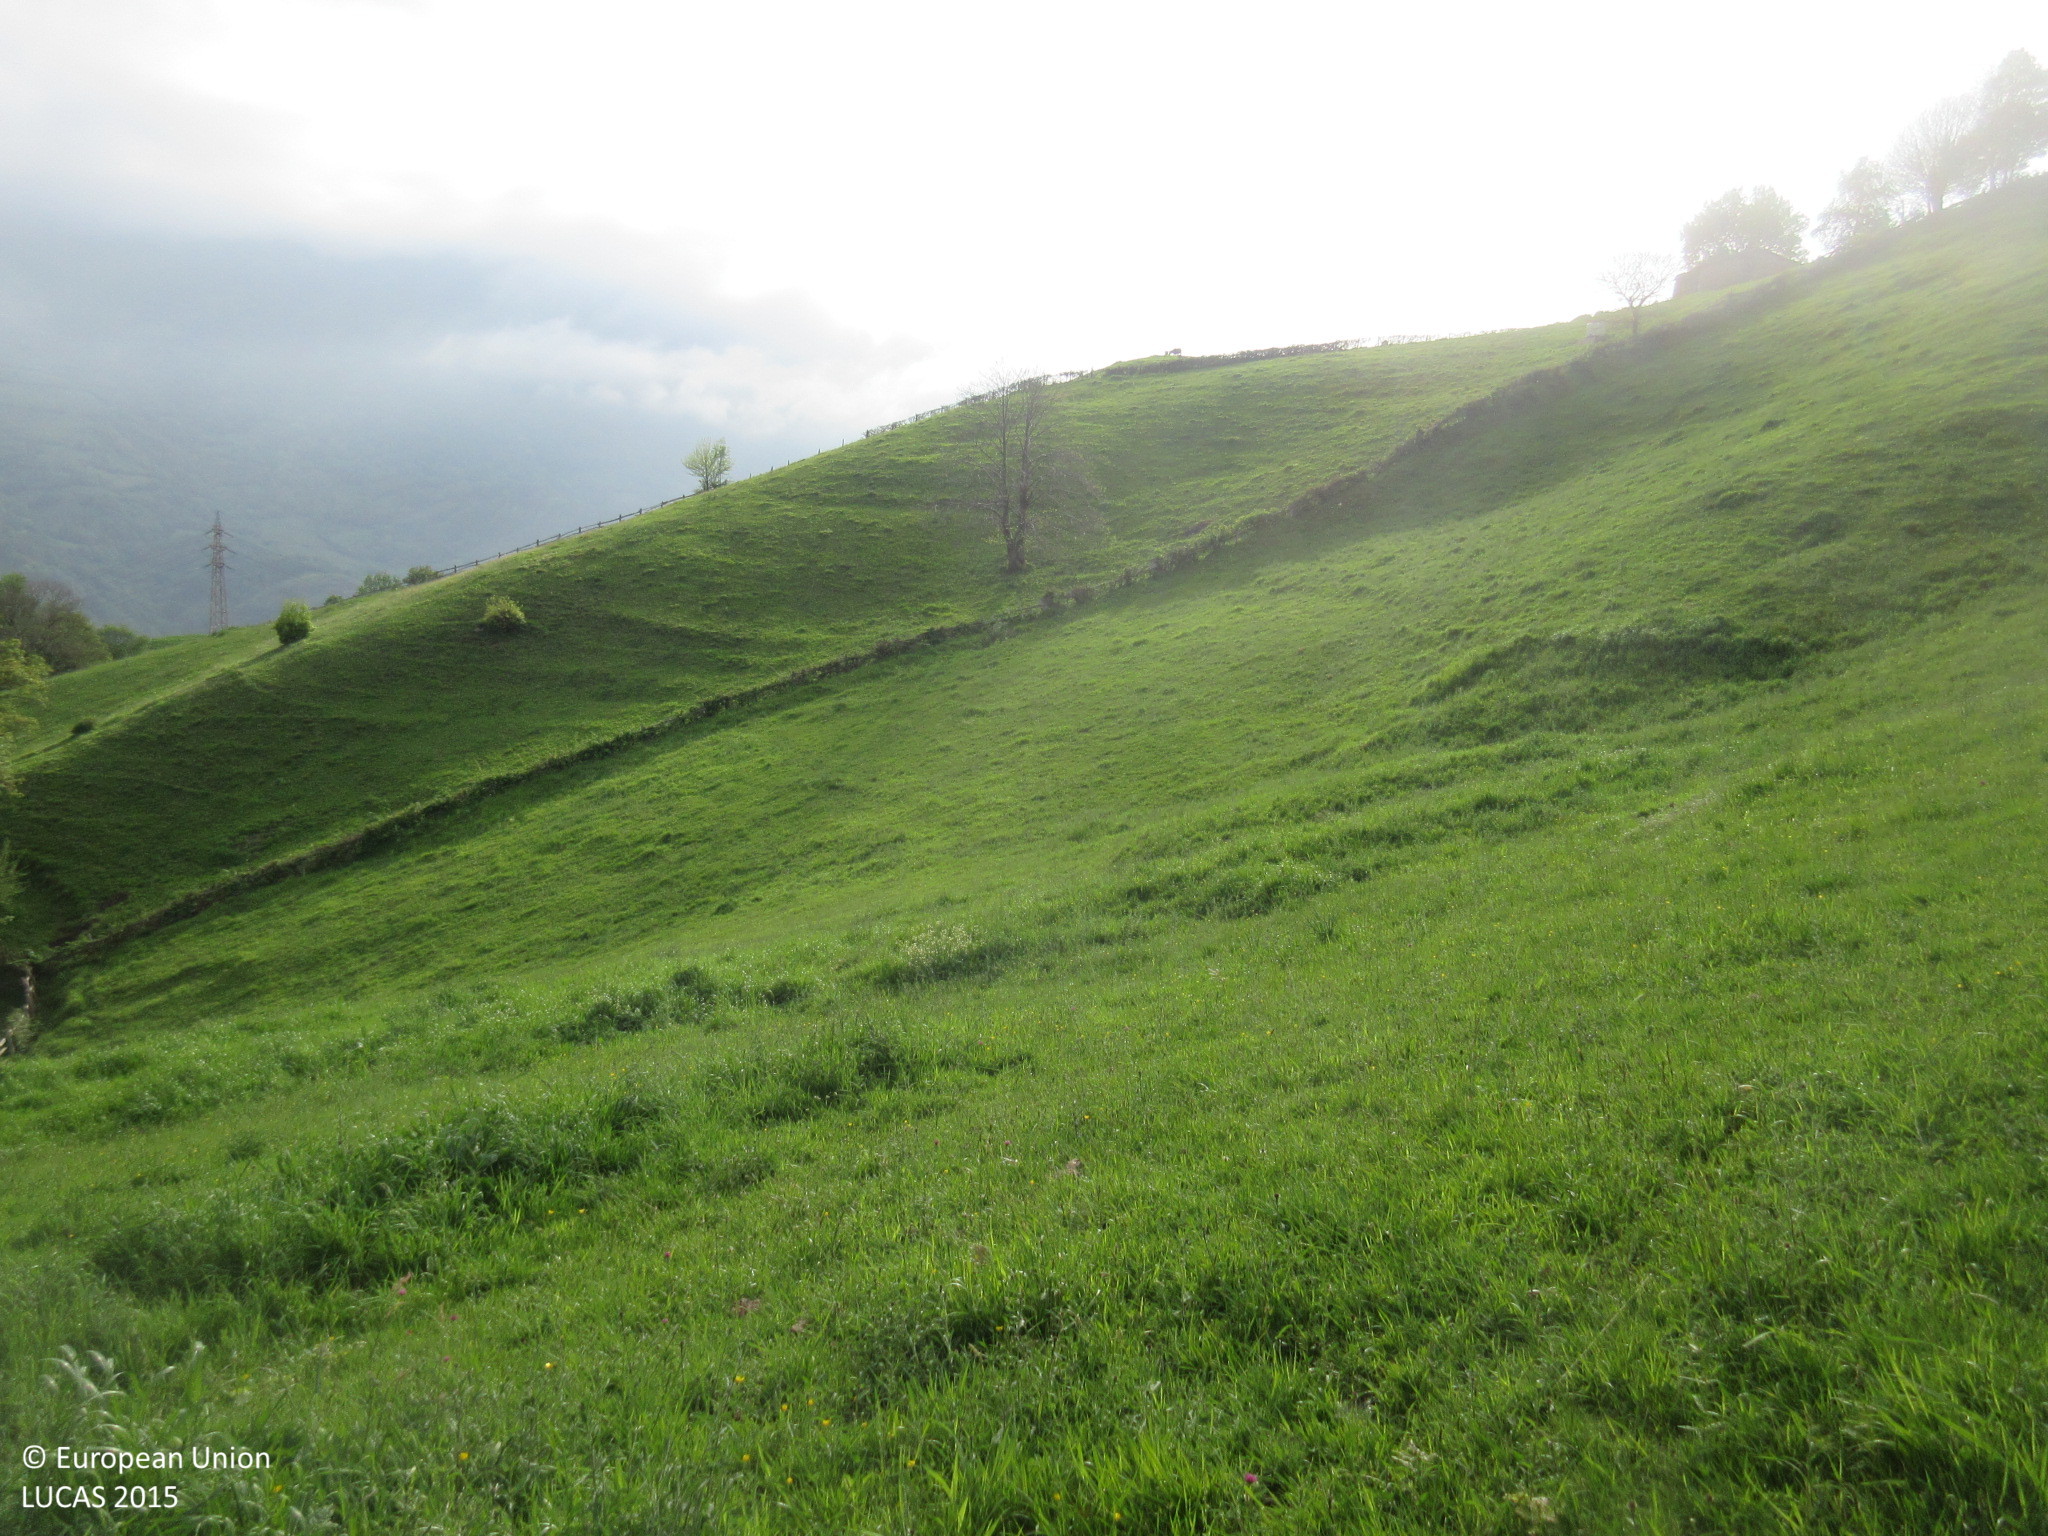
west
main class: Grassland
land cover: Grassland without tree/shrub cover
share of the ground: > 75 %
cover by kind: herbaceous plants 100 %
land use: Agriculture (excluding fallow land and kitchen gardens)
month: May
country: ES
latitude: 43.2455
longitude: -5.8885
